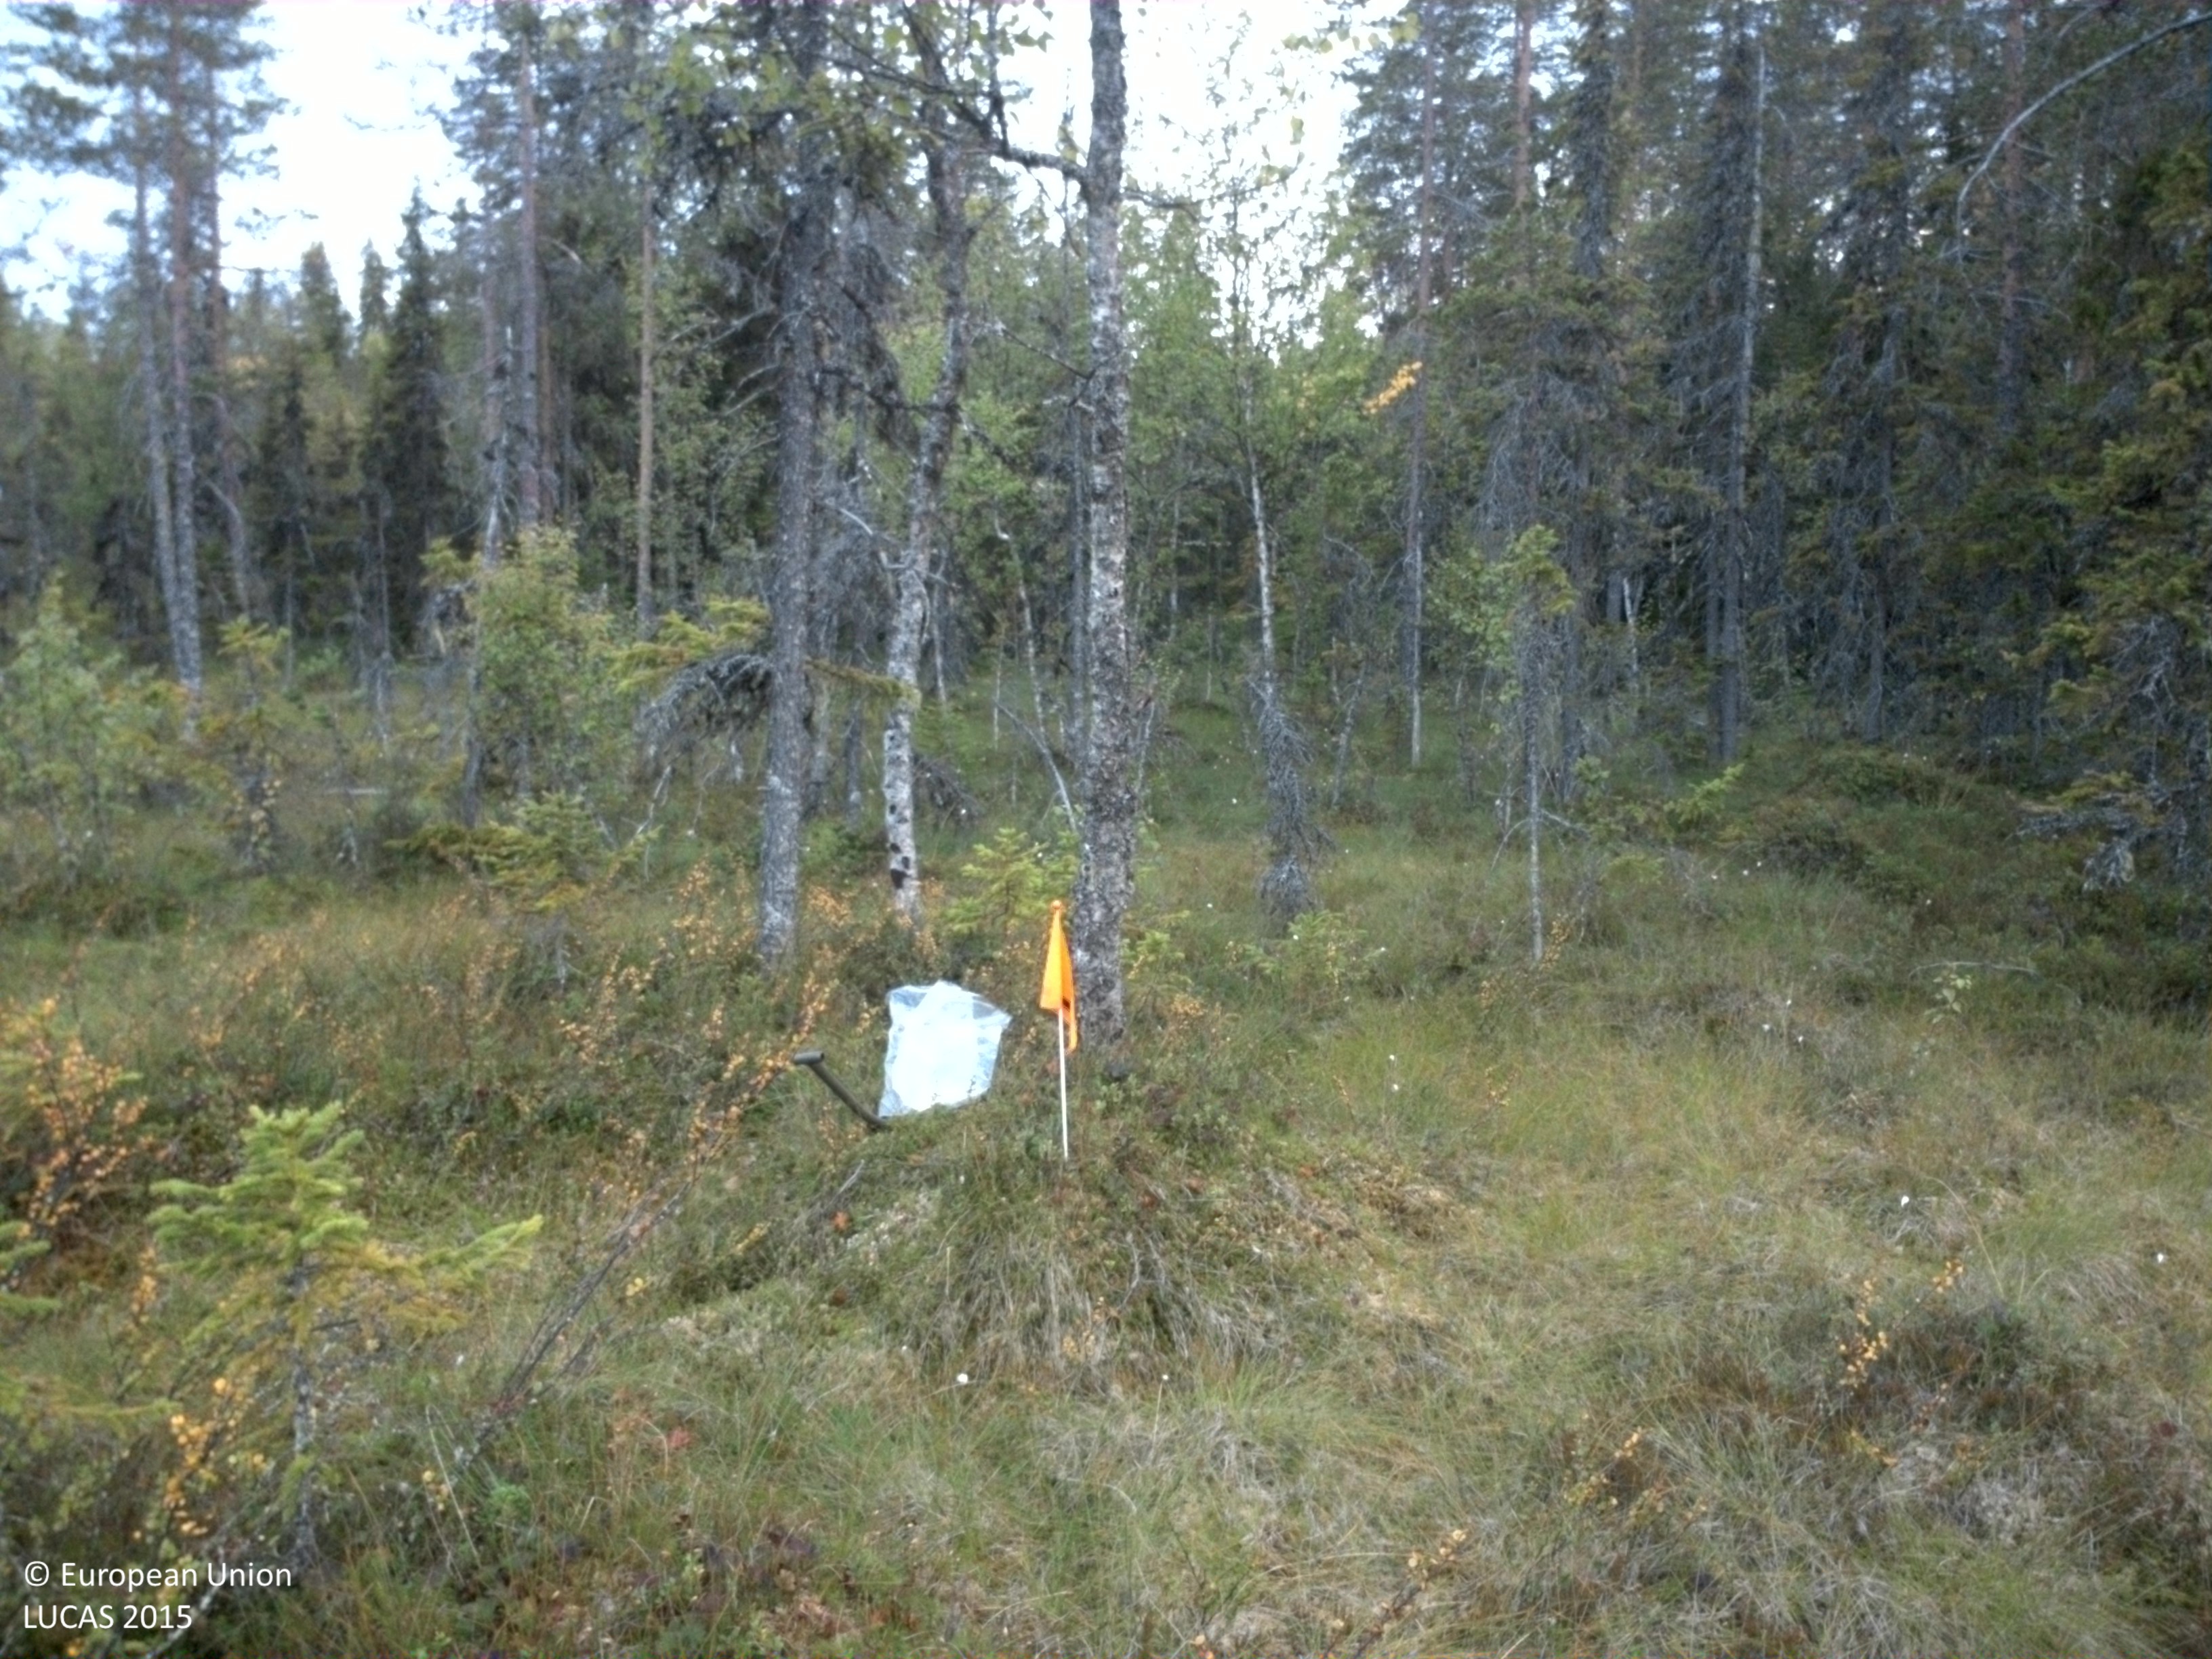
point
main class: Woodland
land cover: Other mixed woodland
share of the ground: 25 - 50 %
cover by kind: shrubs 25 %, lichens and mosses 25 %, coniferous forest trees 20 %, broadleaved forest trees 15 %, herbaceous plants 15 %
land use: Forestry
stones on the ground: < 10 %
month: August
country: SE
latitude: 61.7793
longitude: 15.2720
